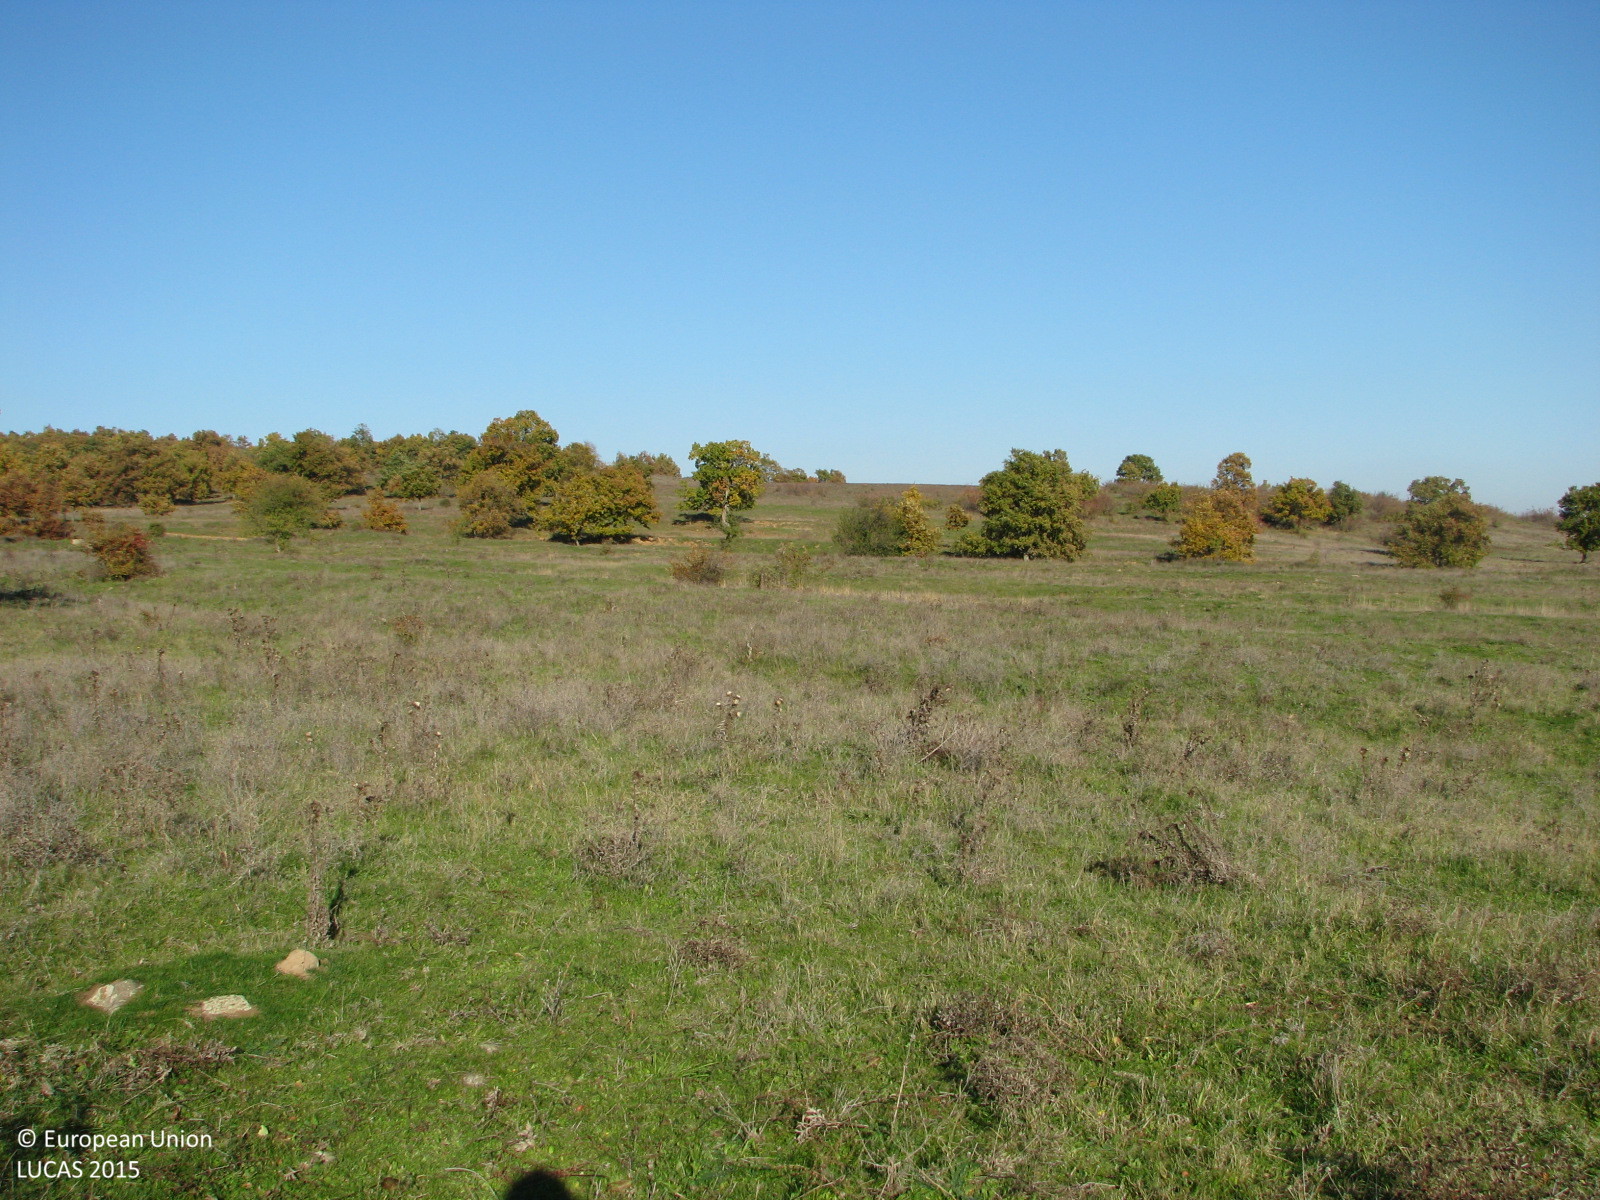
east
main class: Grassland
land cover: Grassland without tree/shrub cover
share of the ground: > 75 %
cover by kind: herbaceous plants 100 %
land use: Agriculture (excluding fallow land and kitchen gardens)
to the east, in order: Grassland without tree/shrub cover; Tracks; Grassland without tree/shrub cover
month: November
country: BG
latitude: 42.0659
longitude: 26.8079
